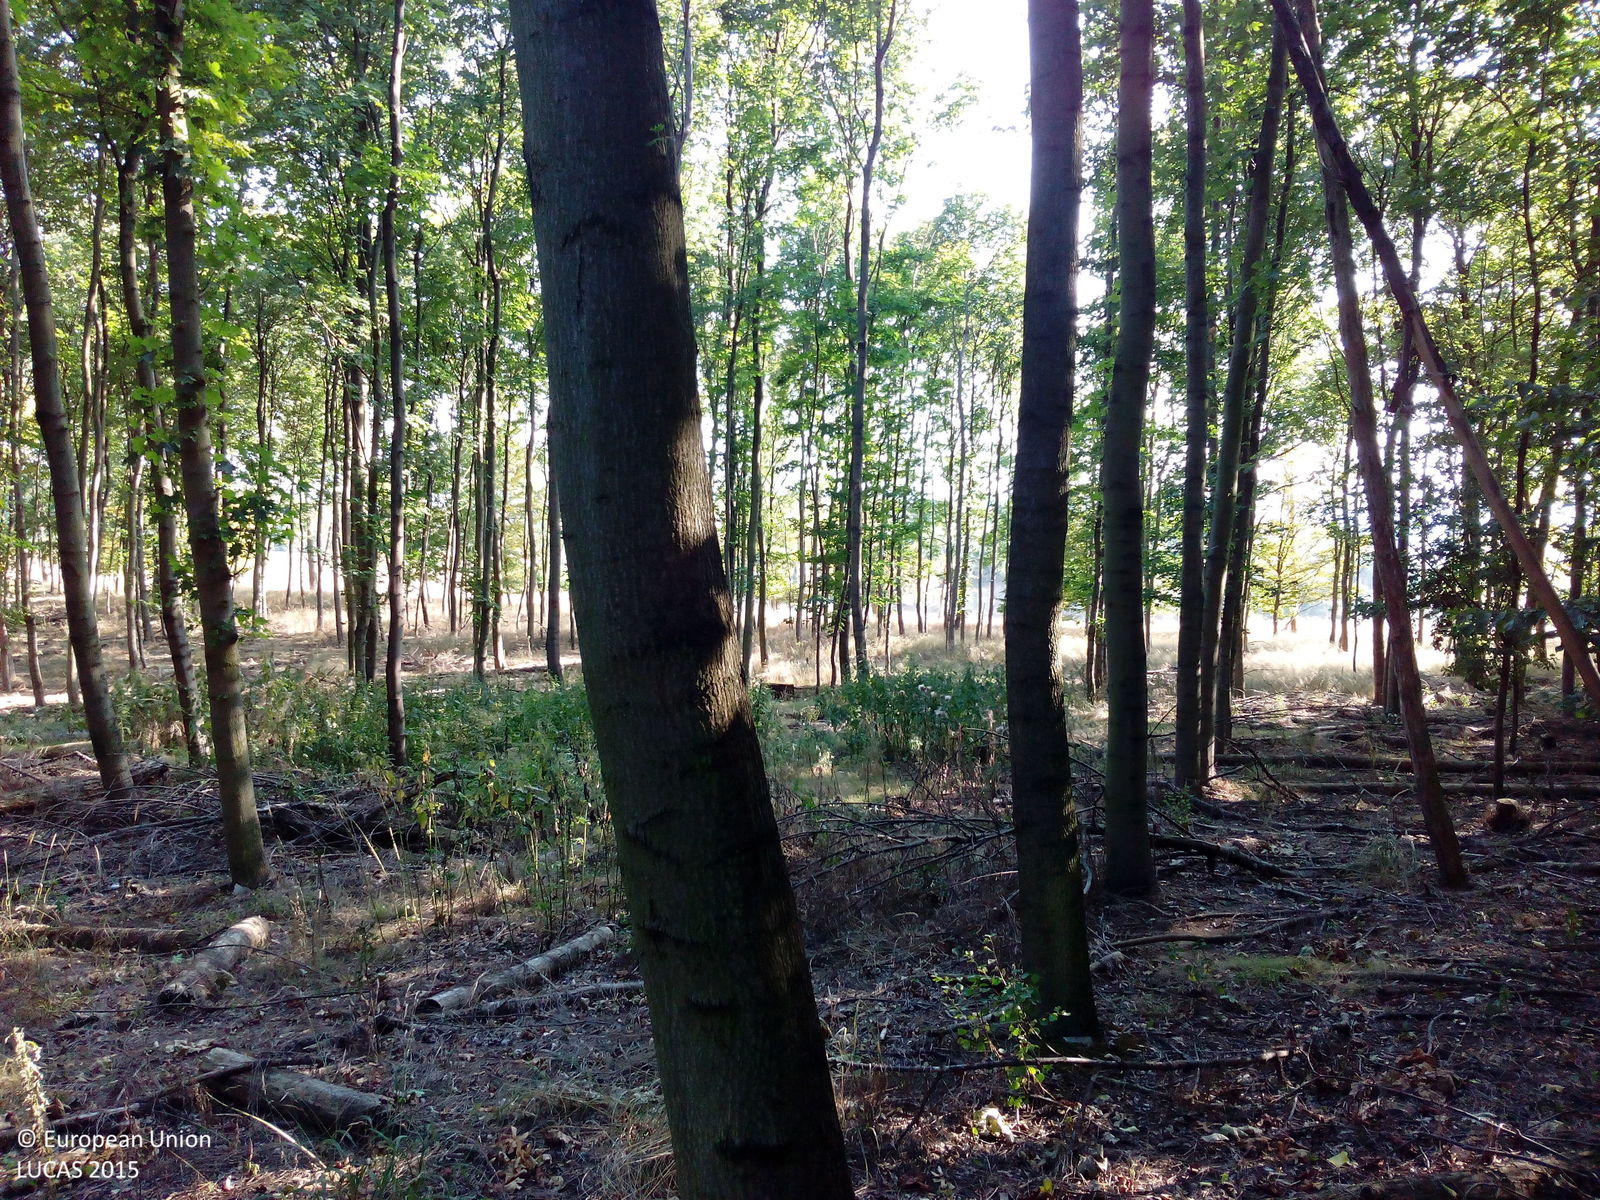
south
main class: Woodland
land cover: Broadleaved woodland
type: beech forest
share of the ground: > 75 %
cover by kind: broadleaved forest trees 90 %, shrubs 5 %, unconsolidated bare surface 5 %
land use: Forestry
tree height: > 5 m
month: August
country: DE
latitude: 51.8509
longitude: 11.1175
